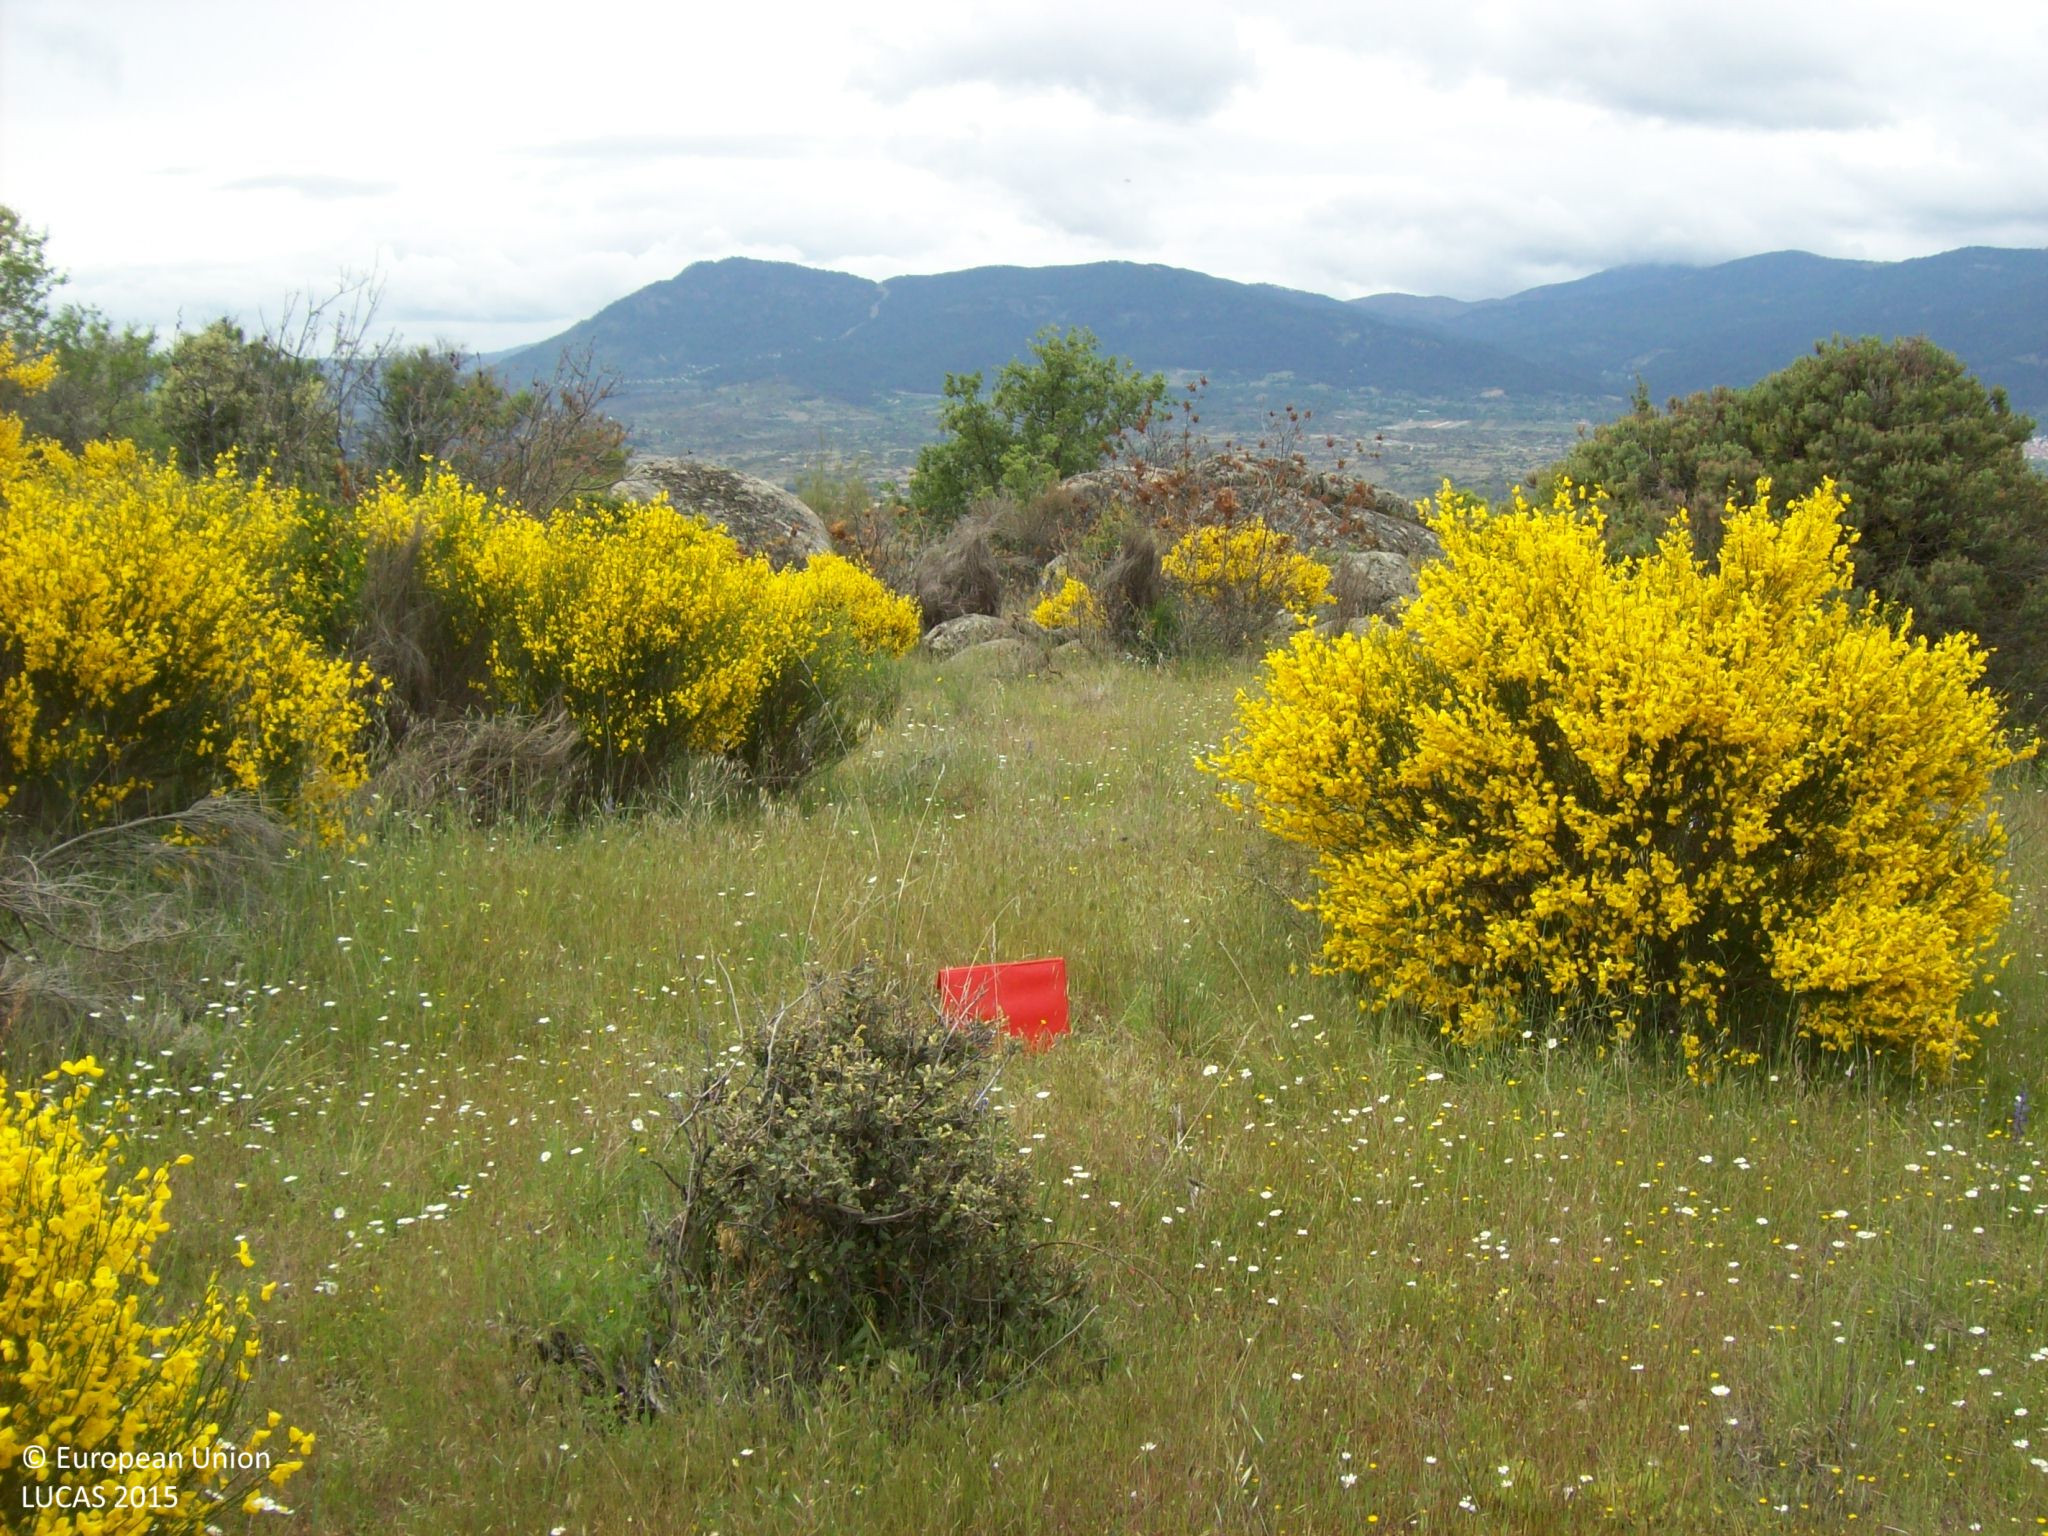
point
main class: Shrubland
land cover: Shrubland with sparse tree cover
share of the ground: 25 - 50 %
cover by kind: herbaceous plants 50 %, shrubs 35 %, broadleaved forest trees 5 %, consolidated bare surface 5 %
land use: Abandoned areas
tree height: < 5 m
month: April
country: ES
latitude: 40.4574
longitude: -4.4472
